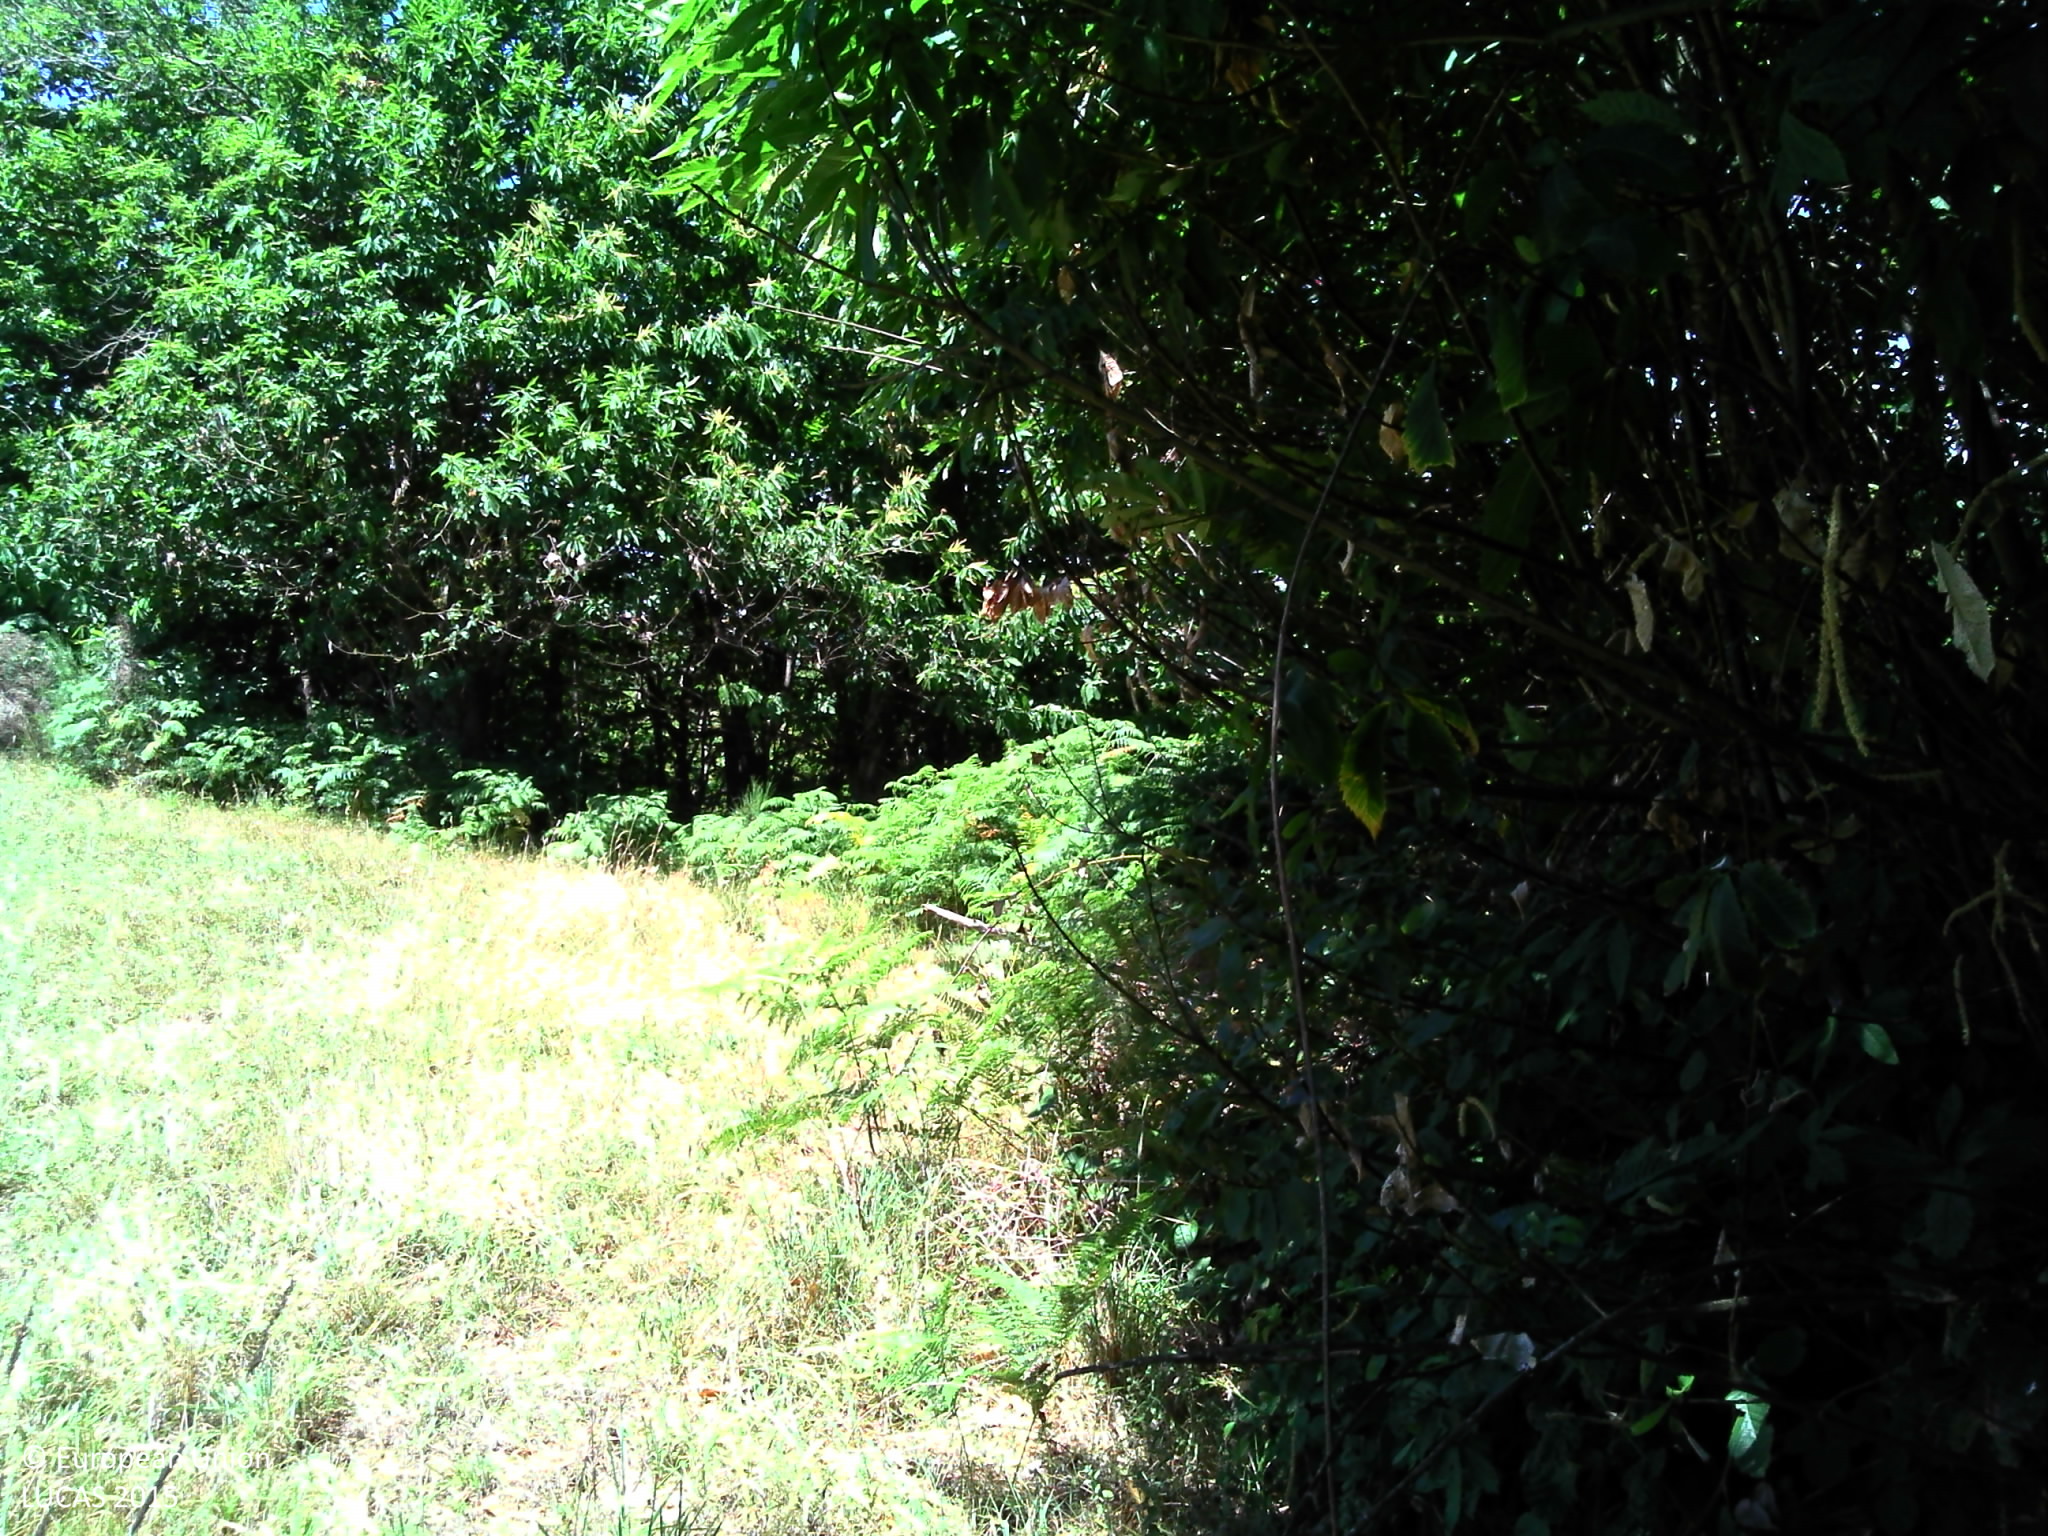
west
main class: Woodland
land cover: Broadleaved woodland
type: acidophilous oak and oak-birch forest
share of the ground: > 75 %
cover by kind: broadleaved forest trees 90 %, herbaceous plants 5 %, lichens and mosses 5 %
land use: Forestry
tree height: > 5 m
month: June
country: FR
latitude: 44.6348
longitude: 2.4254
